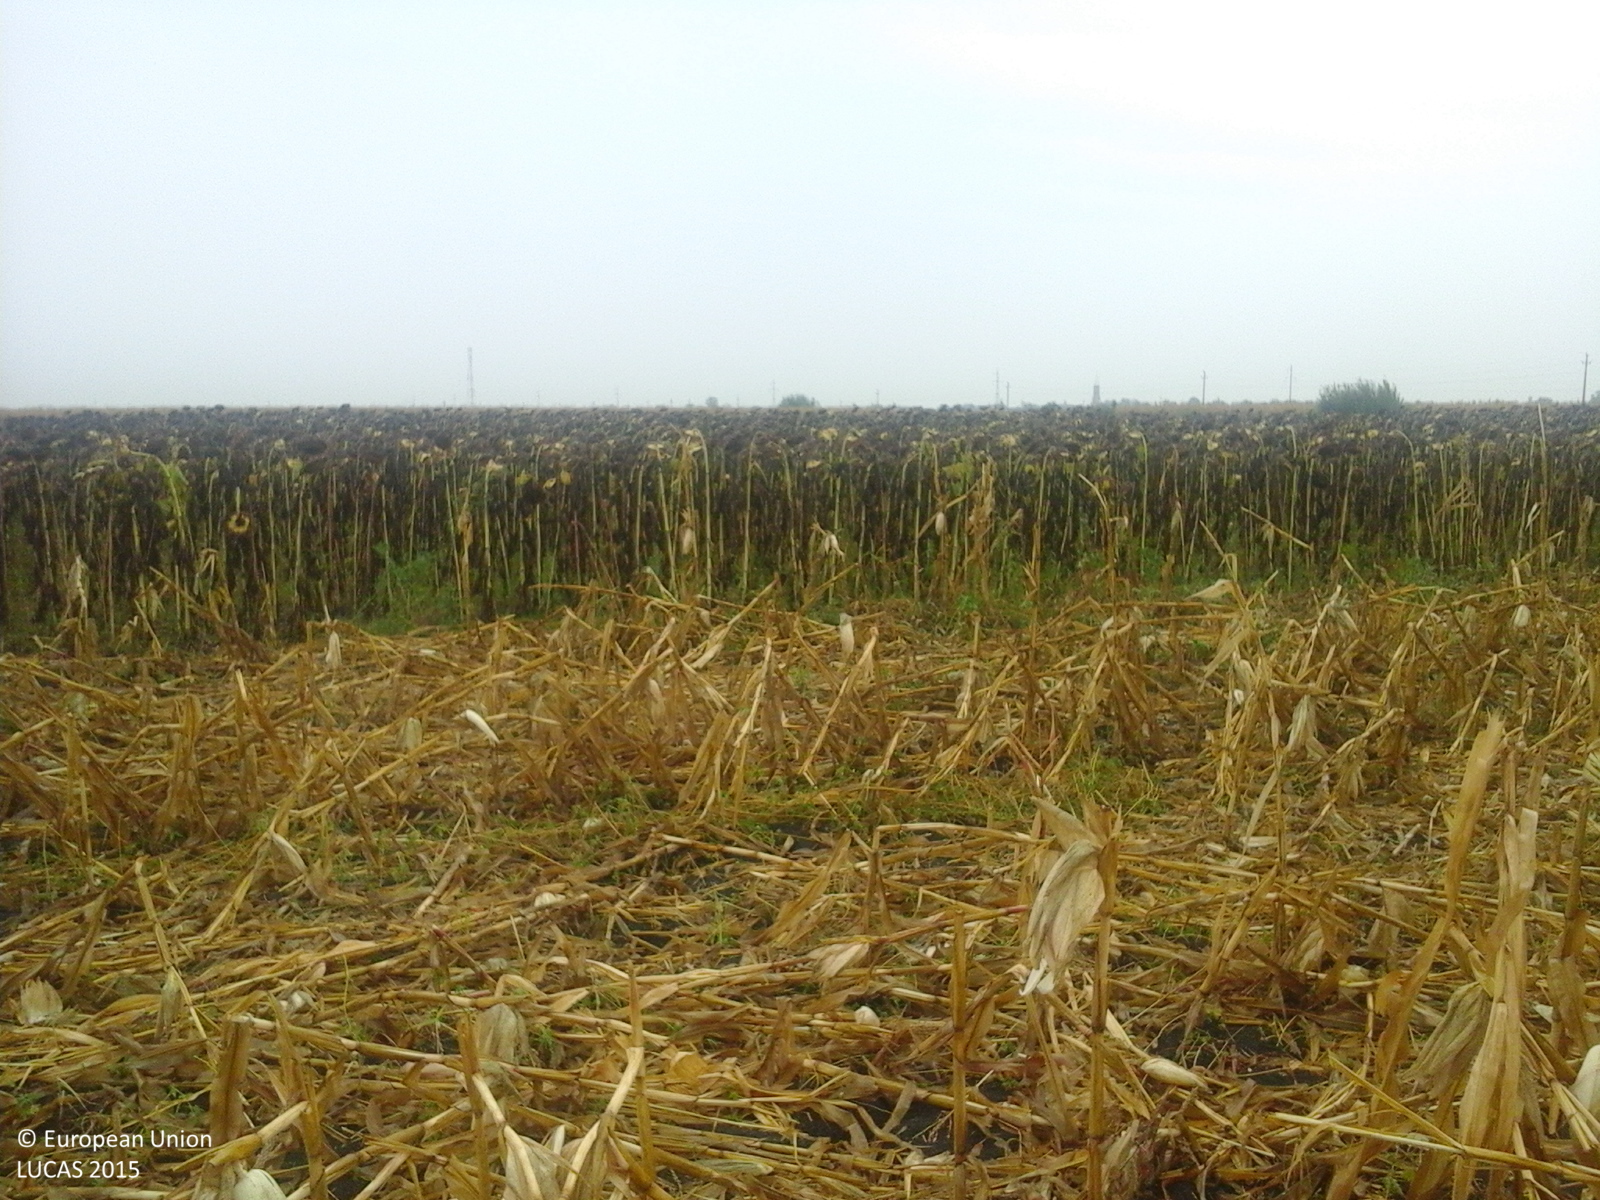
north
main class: Cropland
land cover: Maize
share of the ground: > 75 %
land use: Agriculture (excluding fallow land and kitchen gardens)
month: September
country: RO
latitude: 47.6152
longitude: 22.5241
